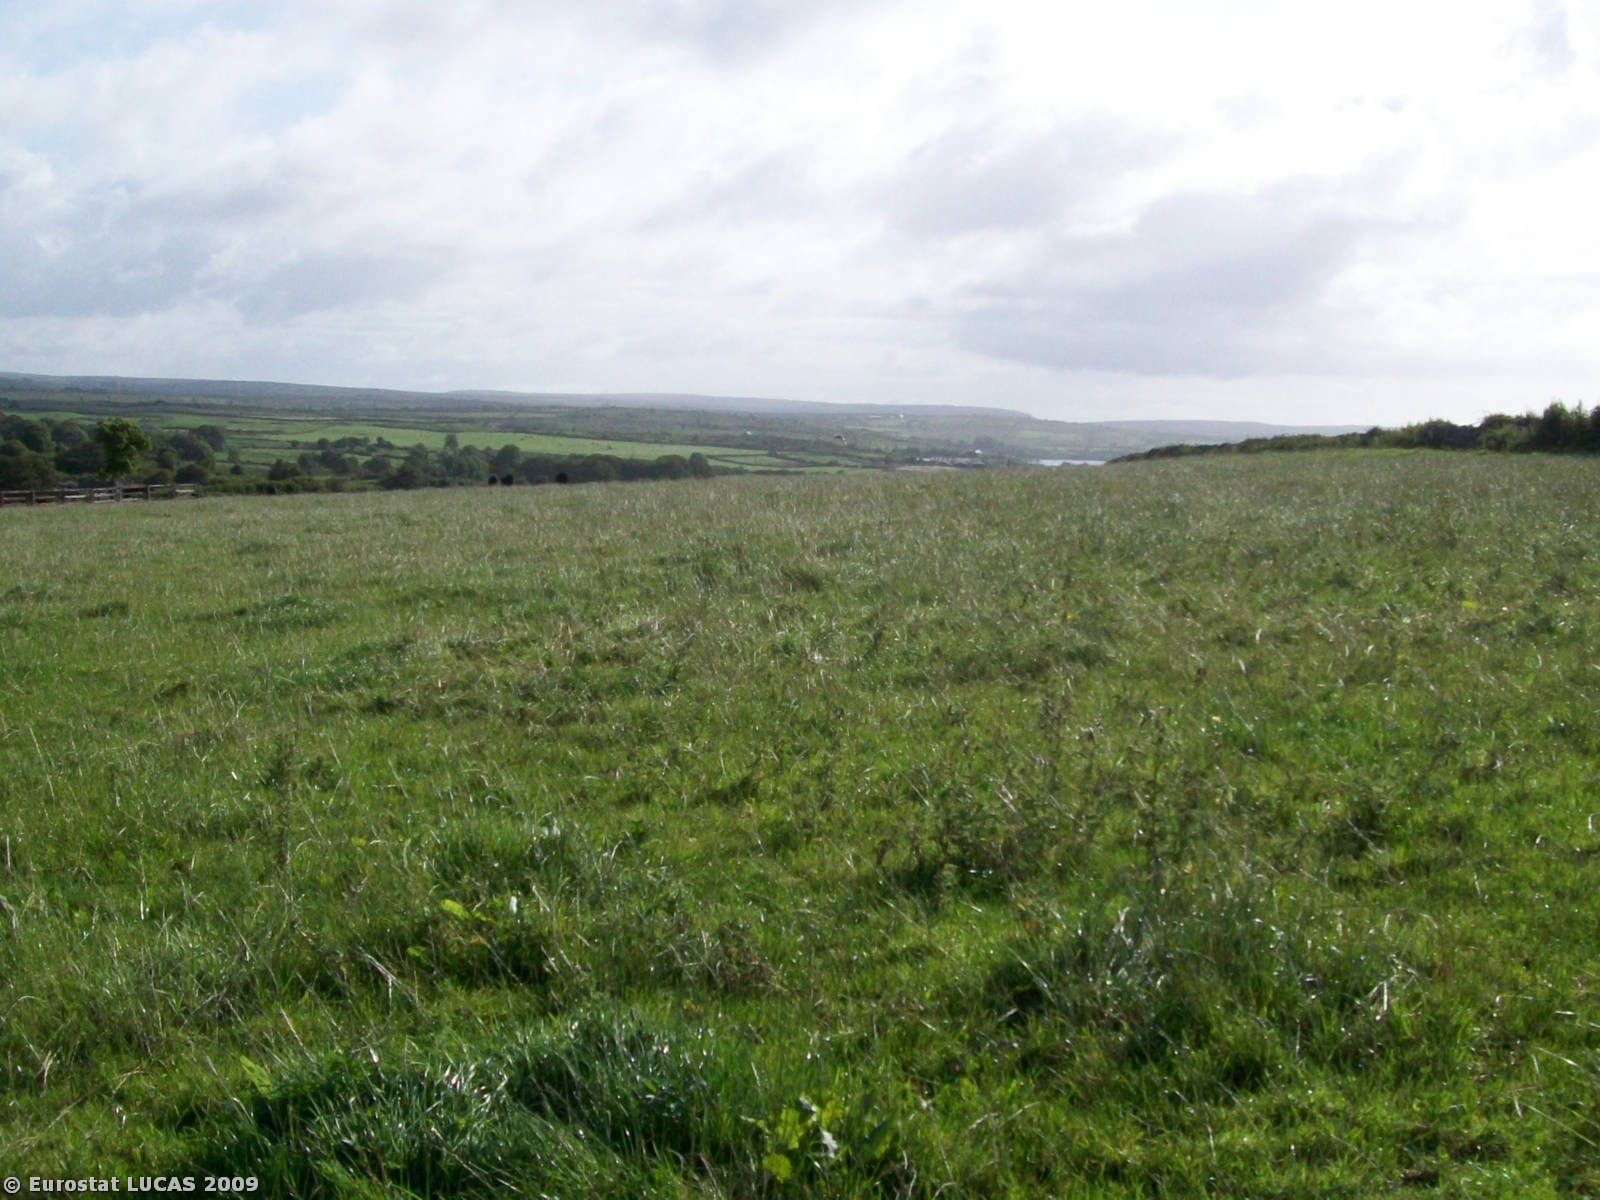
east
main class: Grassland
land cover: Grassland without tree/shrub cover
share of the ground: > 75 %
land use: Agriculture (excluding fallow land and kitchen gardens)
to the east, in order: Grassland without tree/shrub cover; Fences; Grassland without tree/shrub cover; Dry stone walls; Grassland without tree/shrub cover; Dry stone walls; Grassland without tree/shrub cover
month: August
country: IE
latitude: 52.9890
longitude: -9.2148
